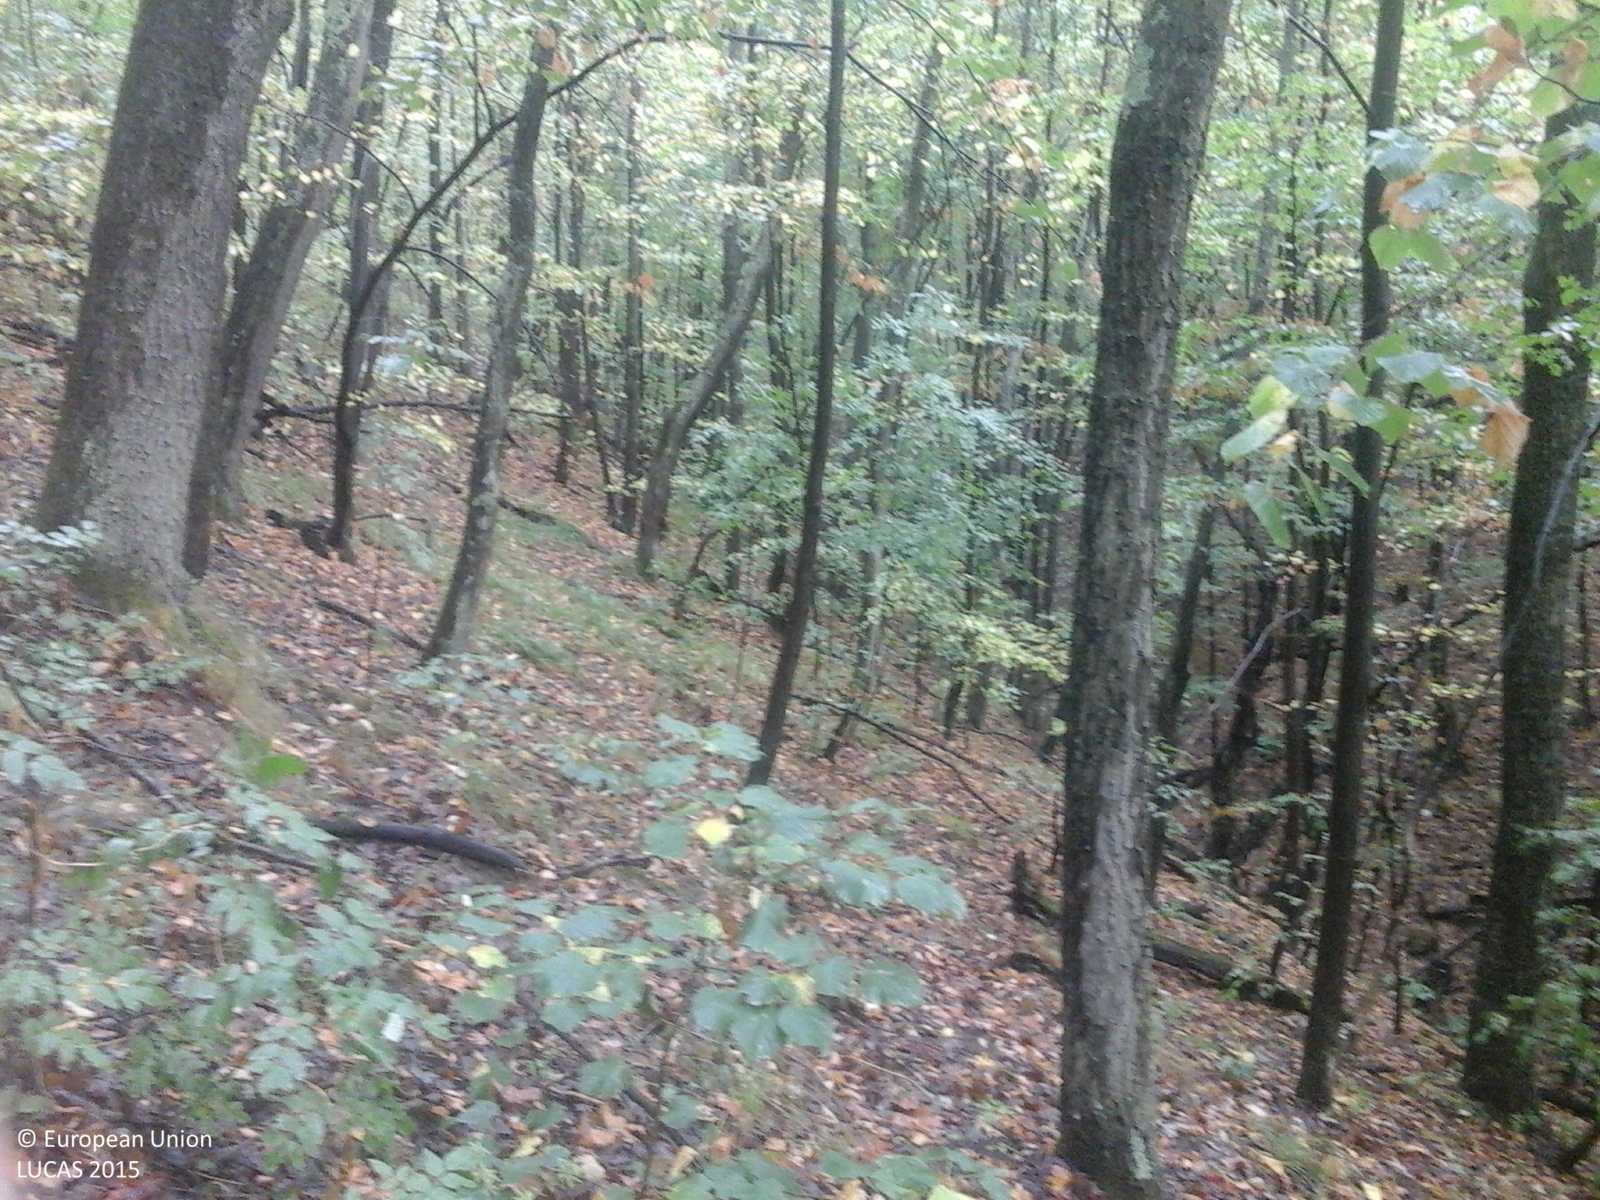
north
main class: Woodland
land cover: Broadleaved woodland
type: thermophilous deciduous forest
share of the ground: > 75 %
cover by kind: broadleaved forest trees 95 %, herbaceous plants 5 %
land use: Forestry
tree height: > 5 m
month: August
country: RO
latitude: 45.0088
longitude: 22.2313
